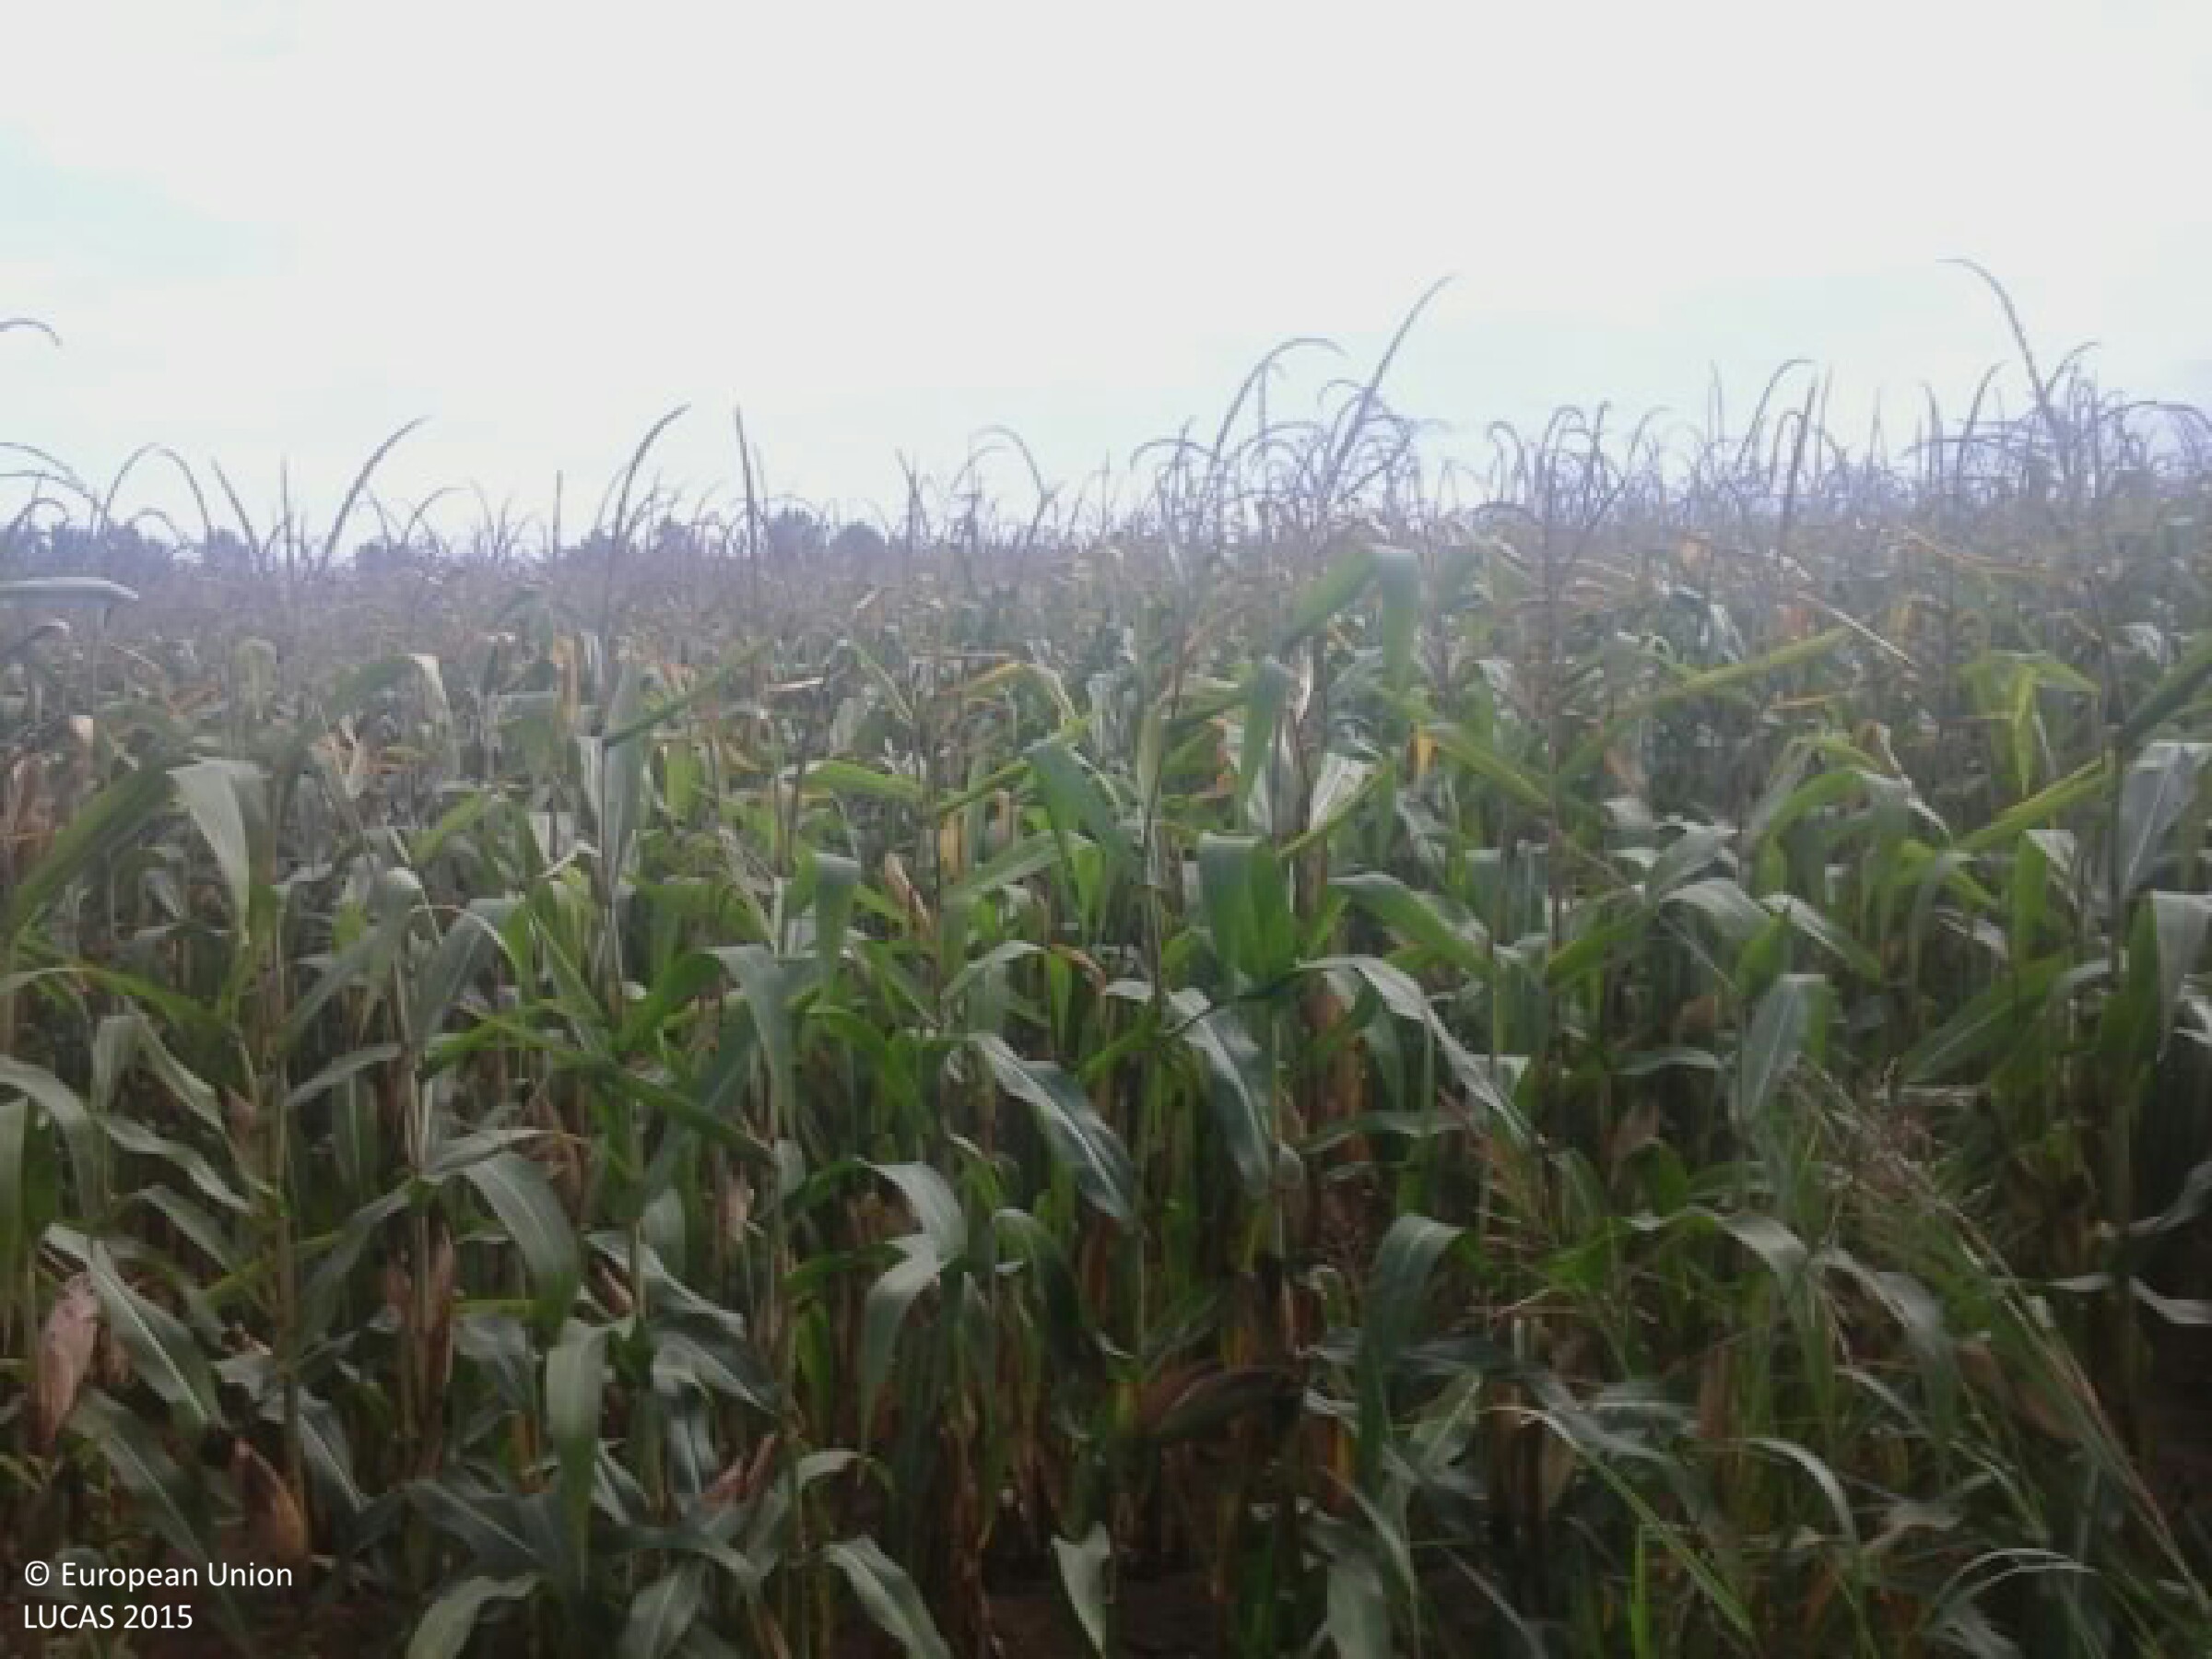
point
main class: Cropland
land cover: Maize
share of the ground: > 75 %
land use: Agriculture (excluding fallow land and kitchen gardens)
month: August
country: HU
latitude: 46.4354
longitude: 17.6974
